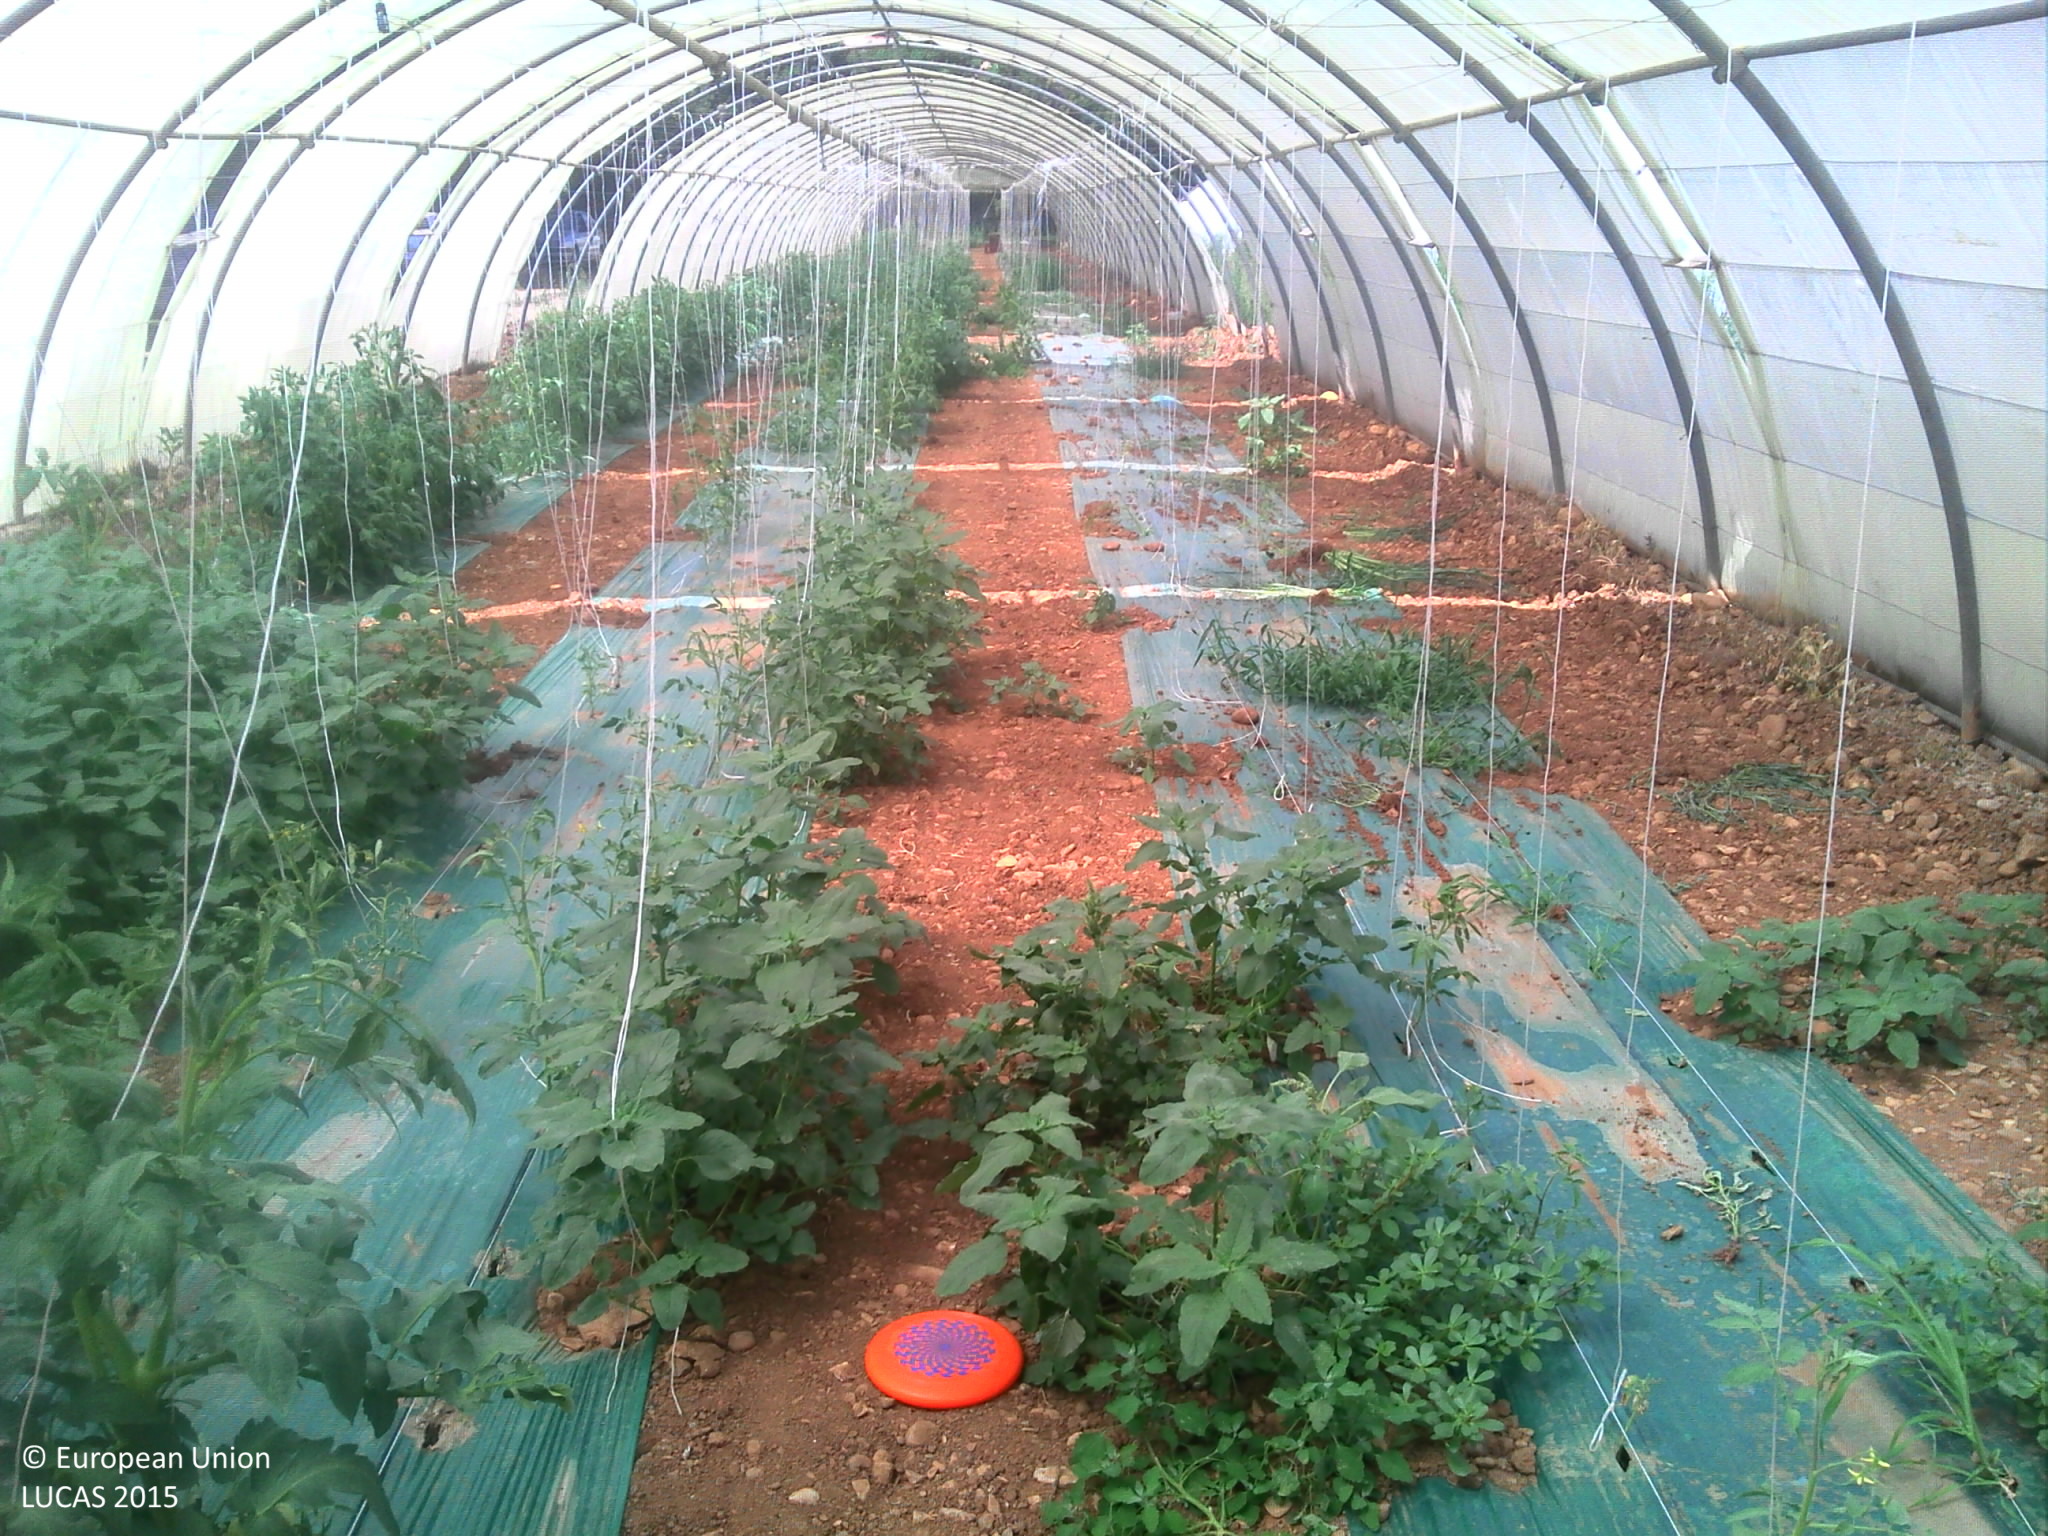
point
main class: Artificial land
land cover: Greenhouses
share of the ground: > 75 %
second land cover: Tomatoes
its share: > 75 %
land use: Agriculture (excluding fallow land and kitchen gardens)
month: July
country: FR
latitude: 43.6618
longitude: 4.8384
